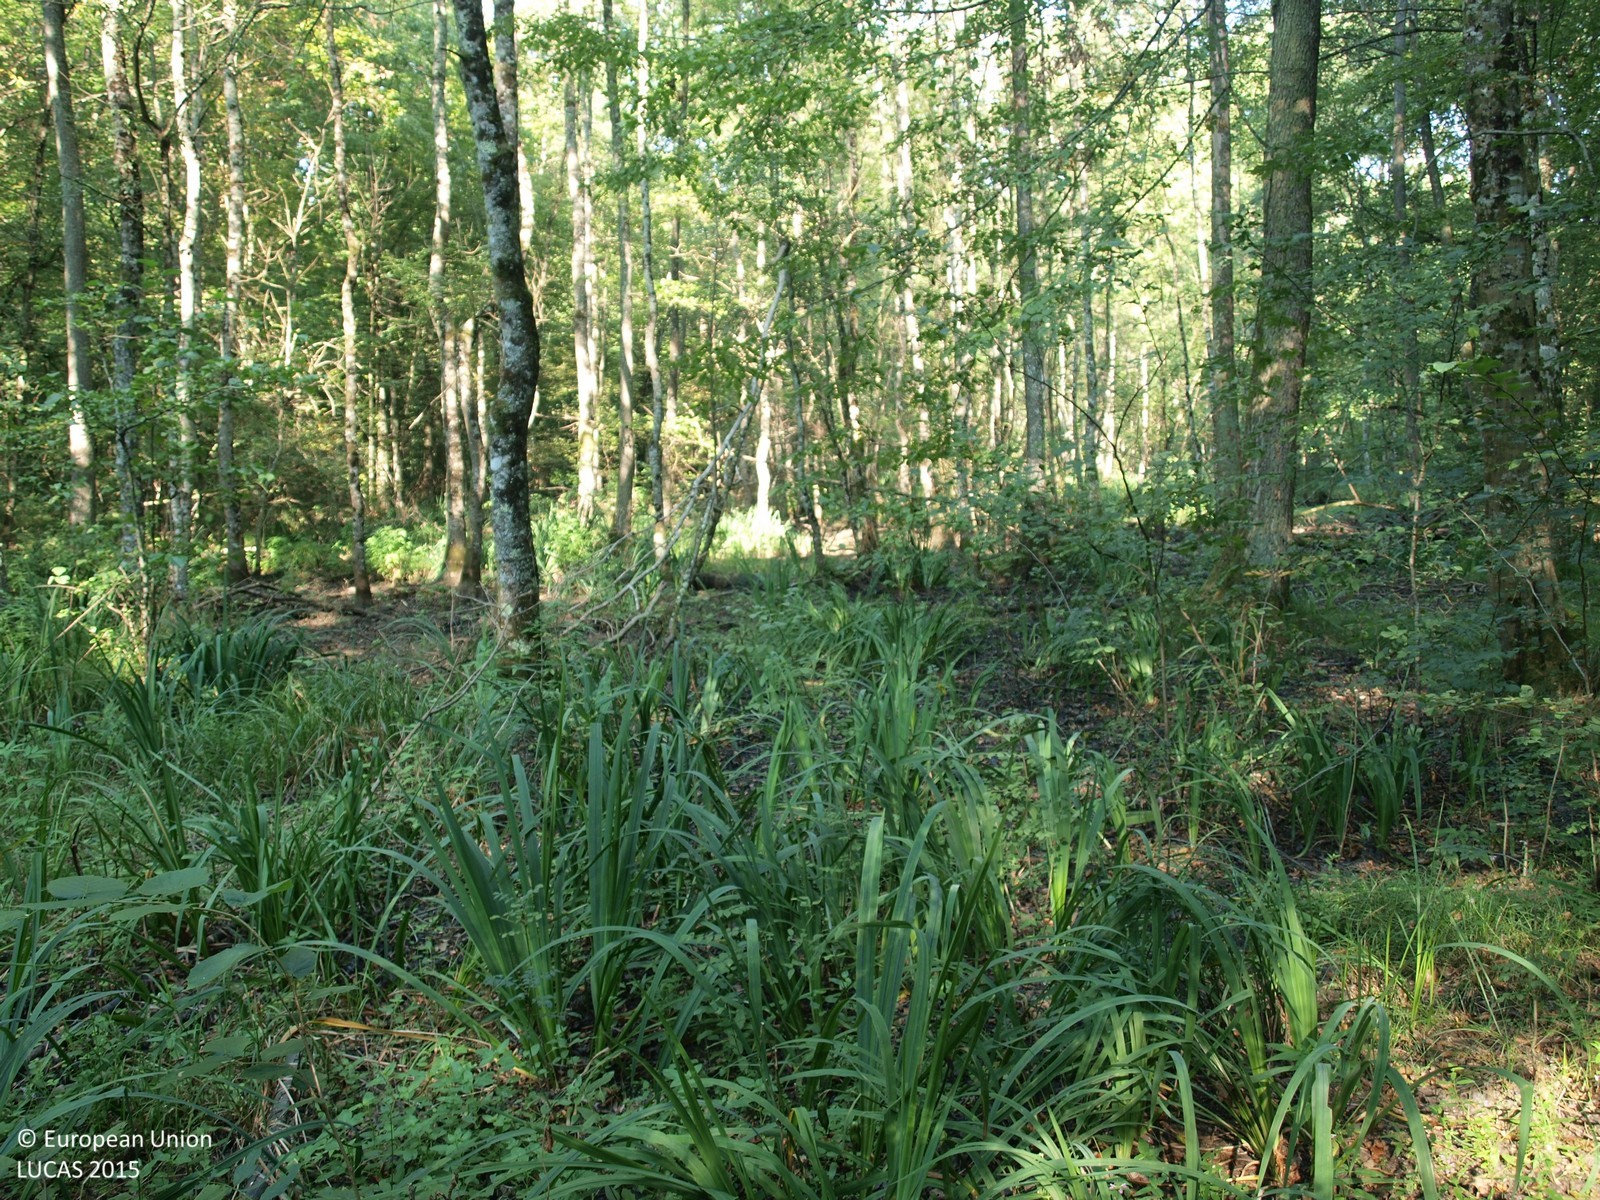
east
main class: Woodland
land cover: Broadleaved woodland
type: floodplain forest
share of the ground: > 75 %
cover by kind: broadleaved forest trees 100 %
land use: Forestry
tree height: > 5 m
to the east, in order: Broadleaved woodland; Tracks; Broadleaved woodland
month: August
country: HR
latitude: 45.6324
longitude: 16.4508
